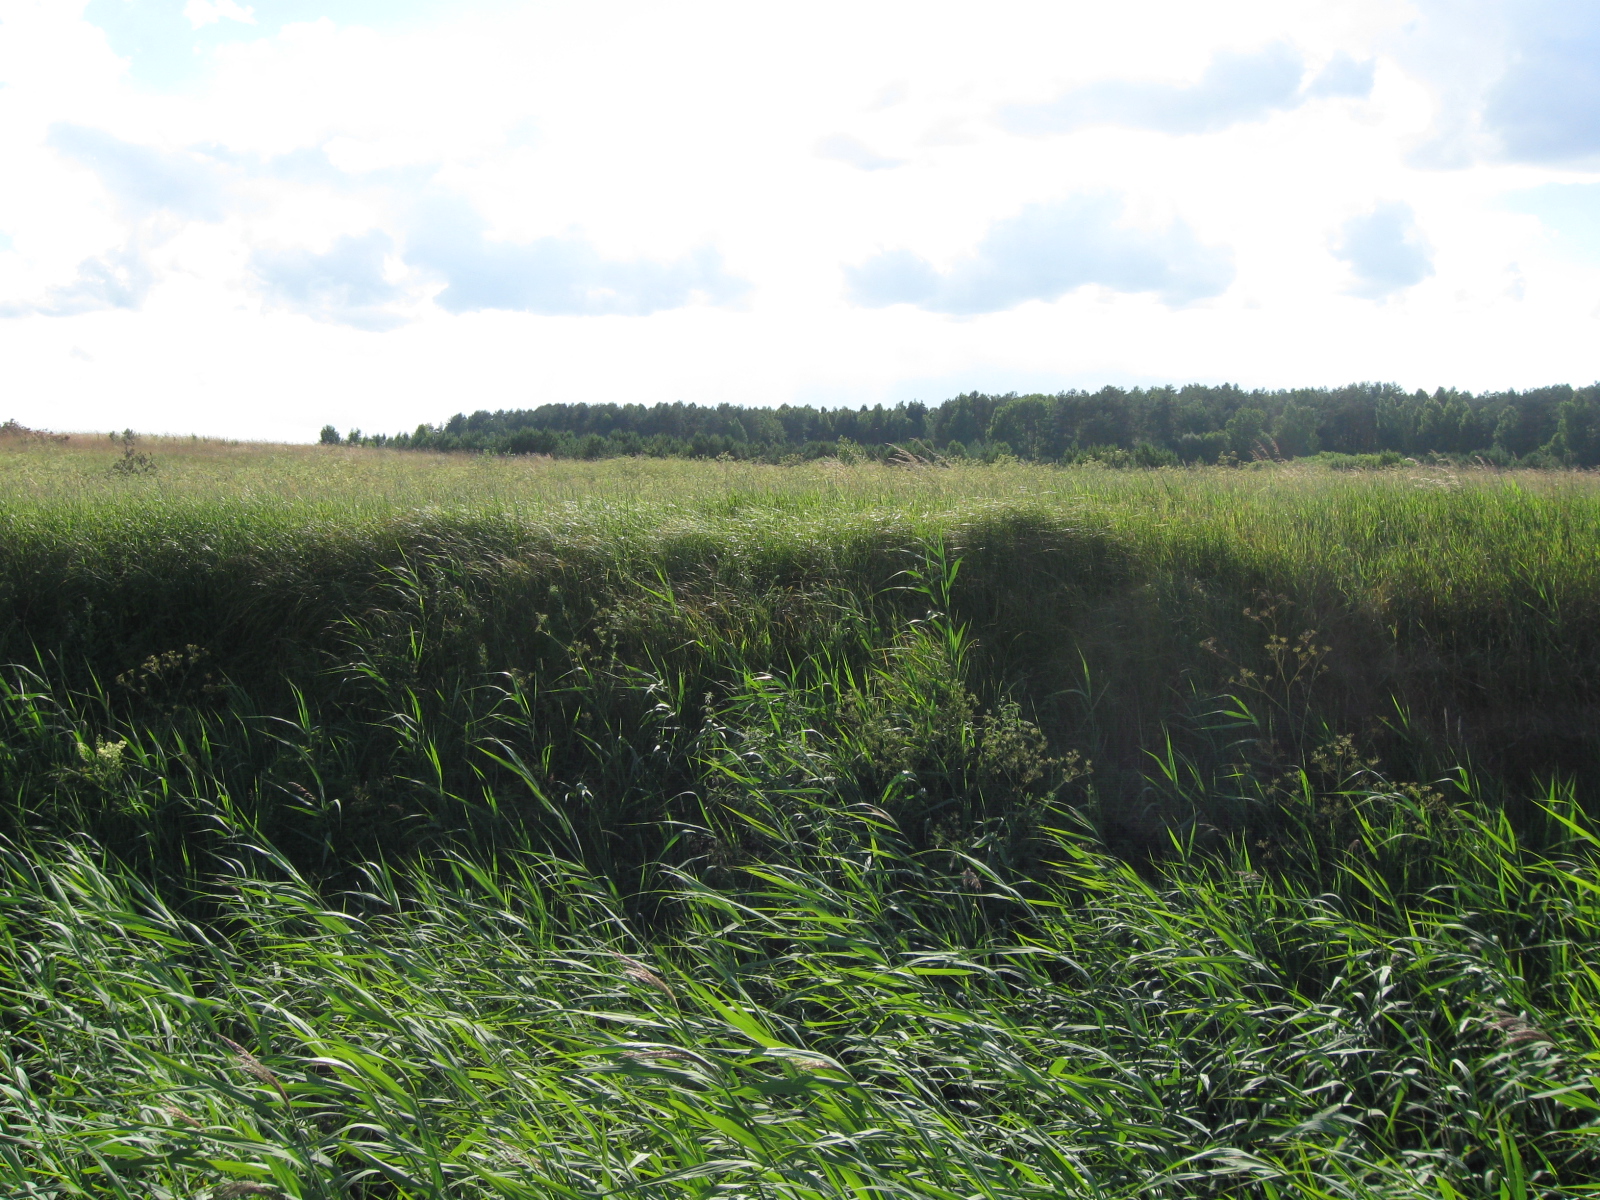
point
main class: Grassland
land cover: Spontaneously vegetated surfaces
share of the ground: > 75 %
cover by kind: herbaceous plants 100 %
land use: Semi-natural and natural areas not in use
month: July
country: LT
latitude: 54.2618
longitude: 24.3312
